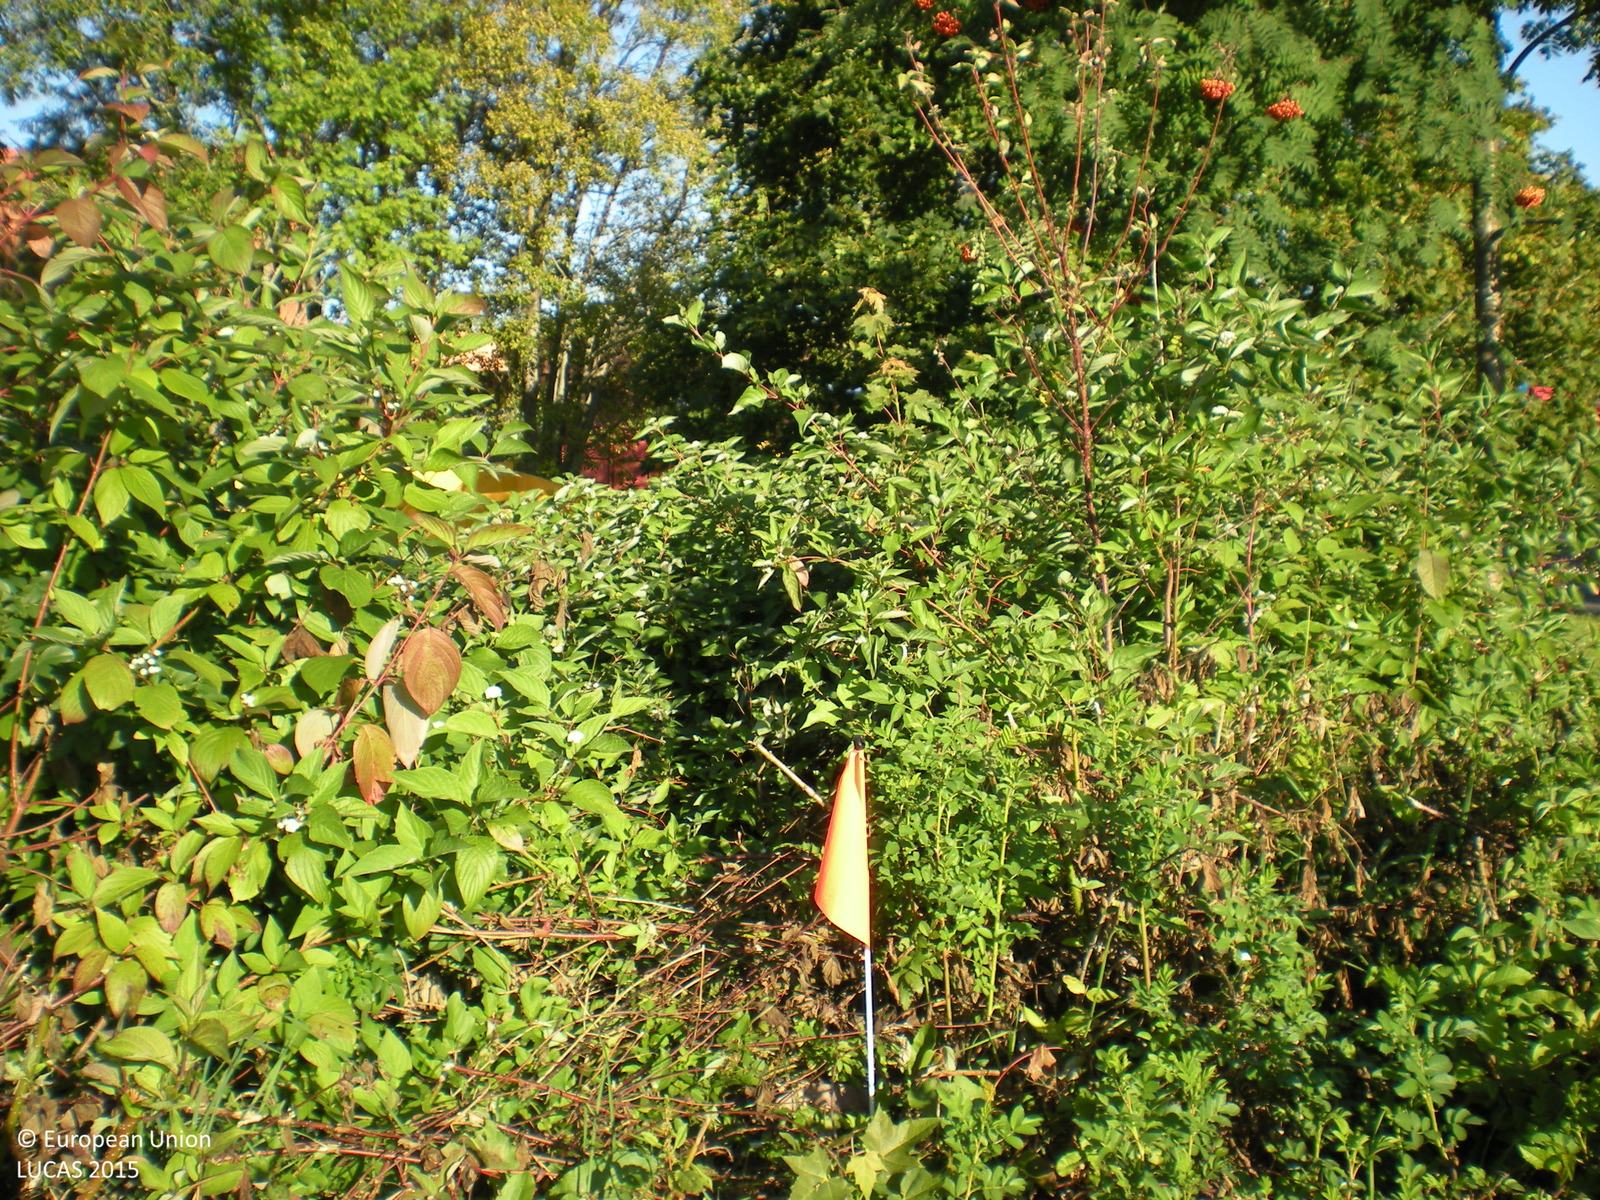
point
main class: Shrubland
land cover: Shrubland with sparse tree cover
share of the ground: > 75 %
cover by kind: shrubs 95 %, broadleaved forest trees 5 %
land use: Amenities, museums, leisure
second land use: Sport
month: August
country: SE
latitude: 60.6509
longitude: 17.1408
